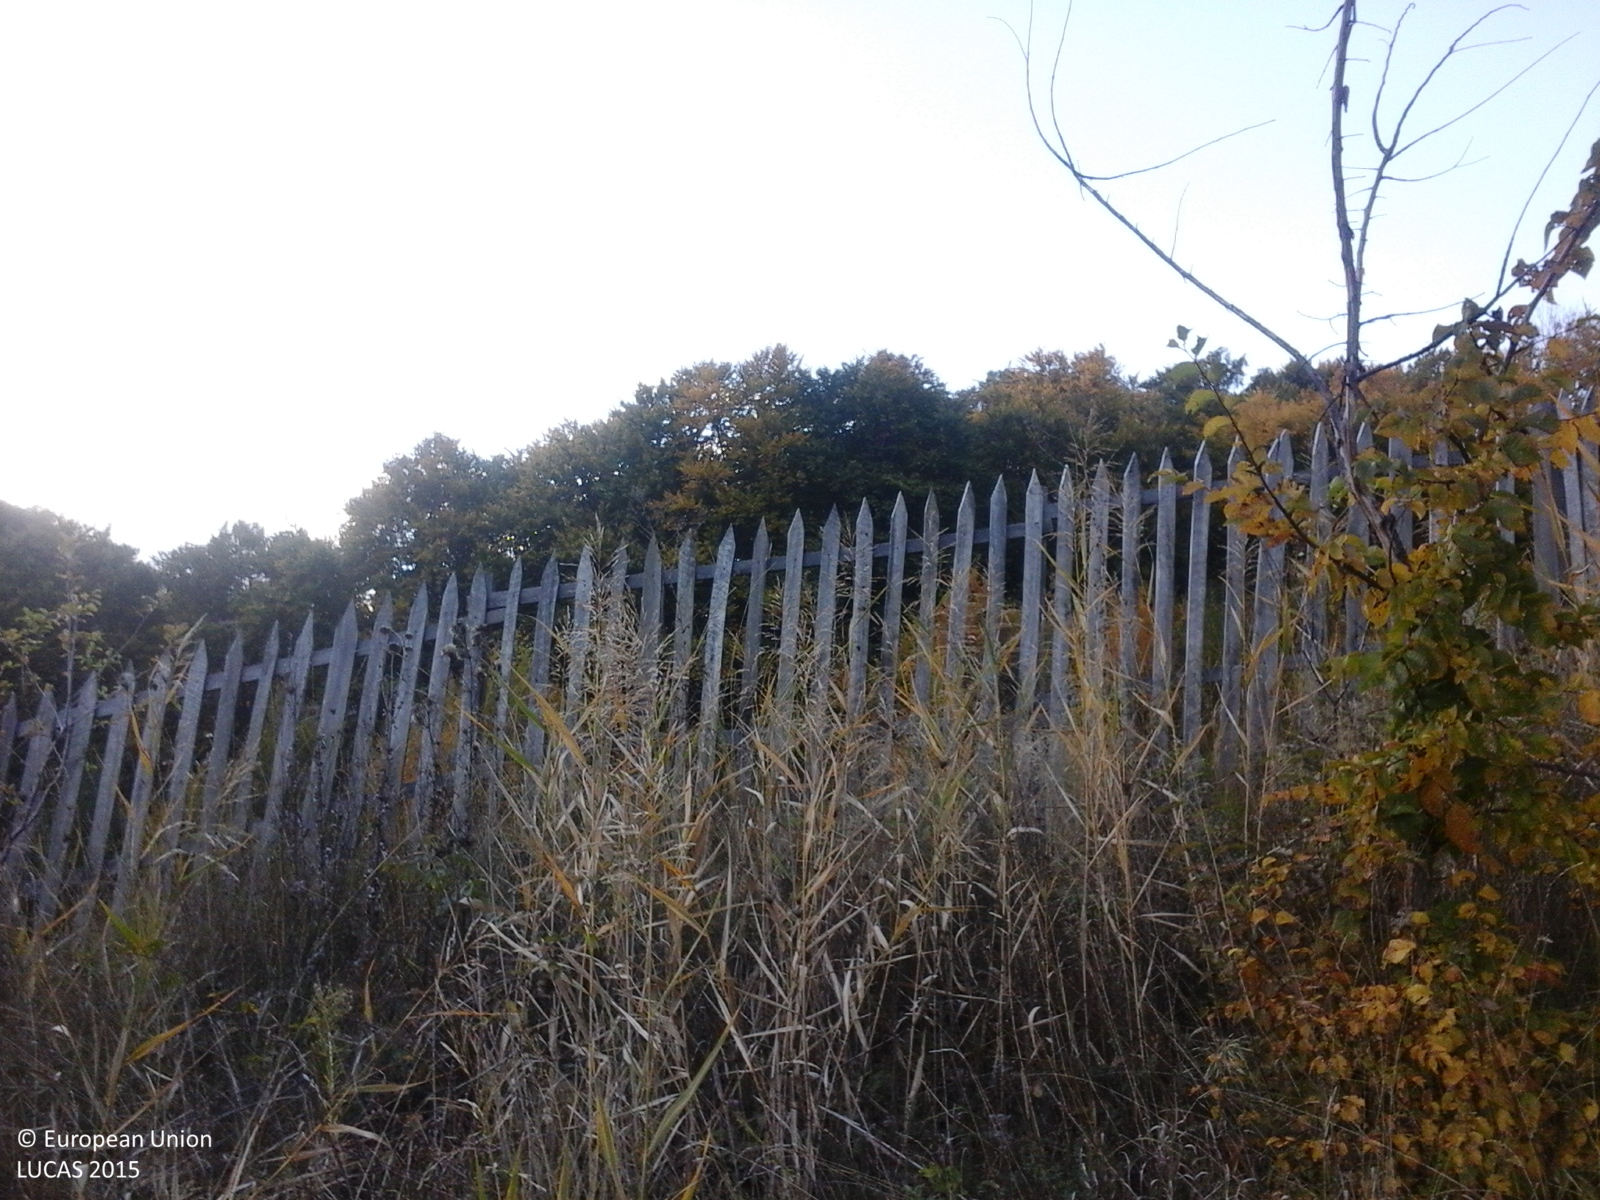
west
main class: Woodland
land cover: Broadleaved woodland
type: acidophilous oak and oak-birch forest
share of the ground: > 75 %
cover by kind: broadleaved forest trees 100 %
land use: Forestry
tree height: > 5 m
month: October
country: RO
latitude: 45.1967
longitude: 26.3227
